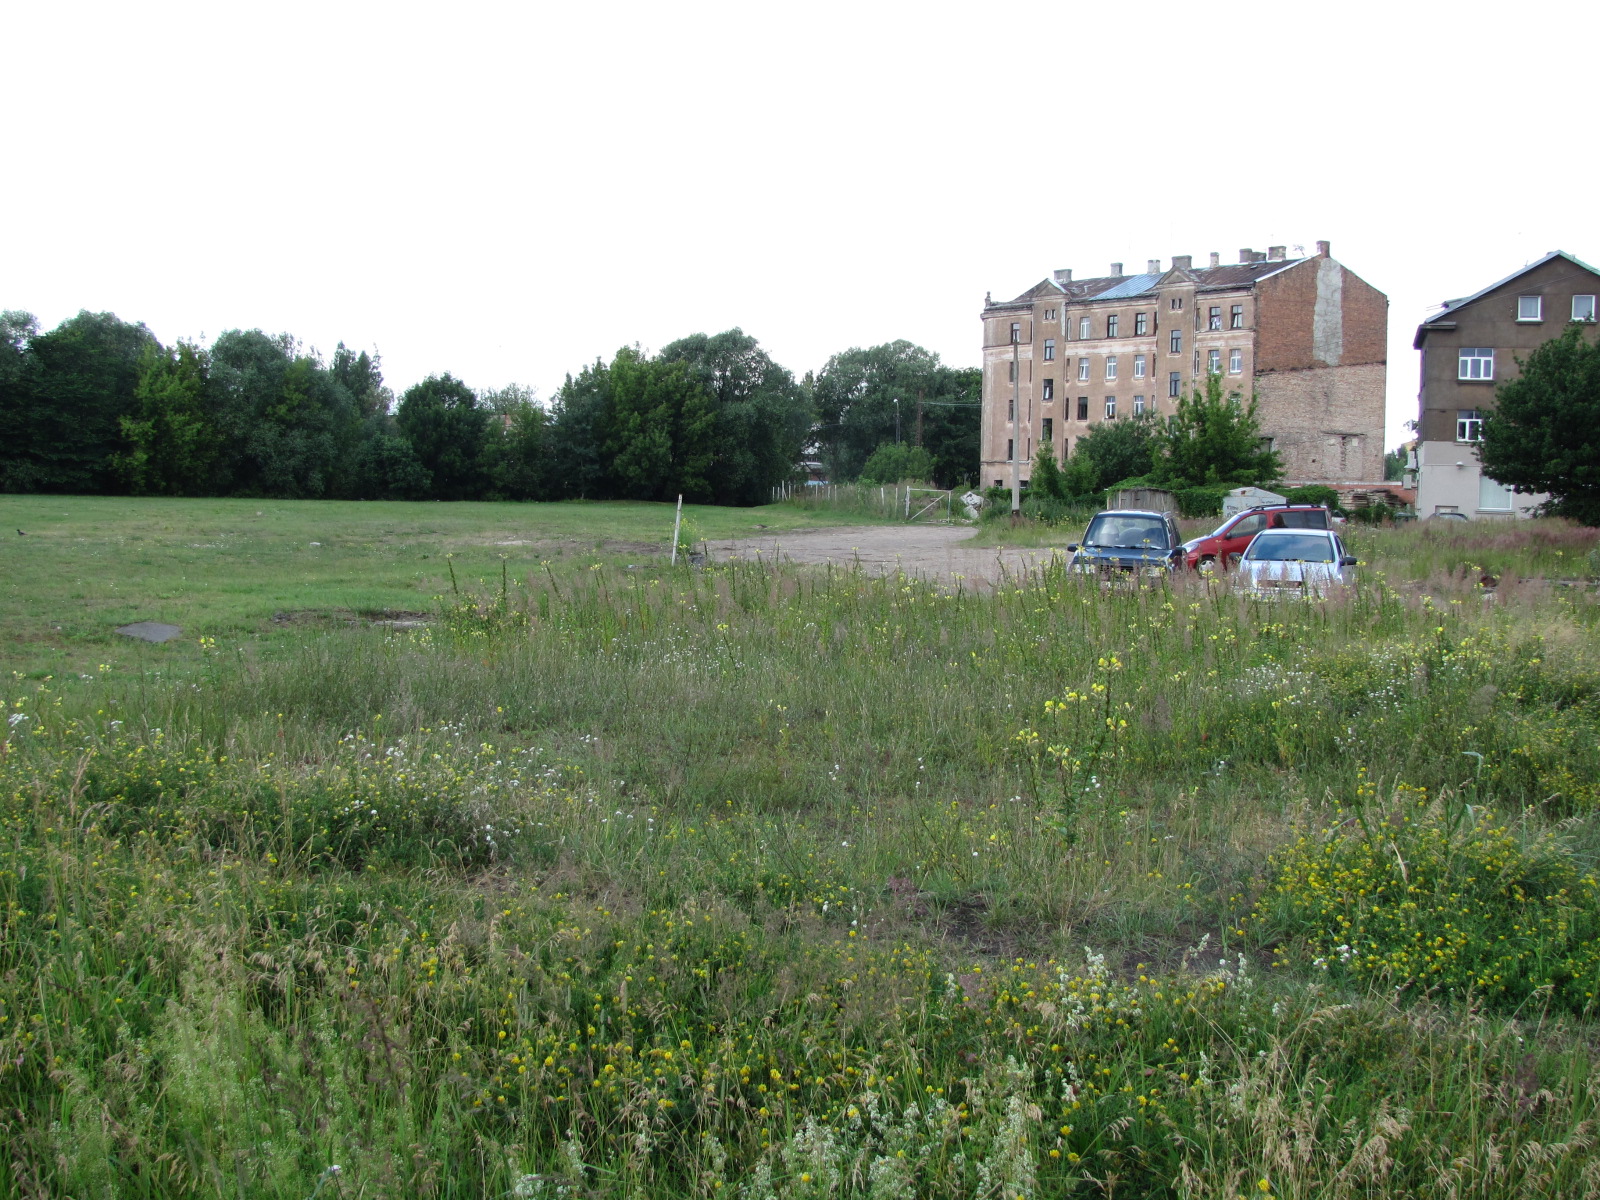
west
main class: Grassland
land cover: Grassland without tree/shrub cover
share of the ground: > 75 %
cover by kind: herbaceous plants 100 %
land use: Community services
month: July
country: LV
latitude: 56.9923
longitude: 24.1253
